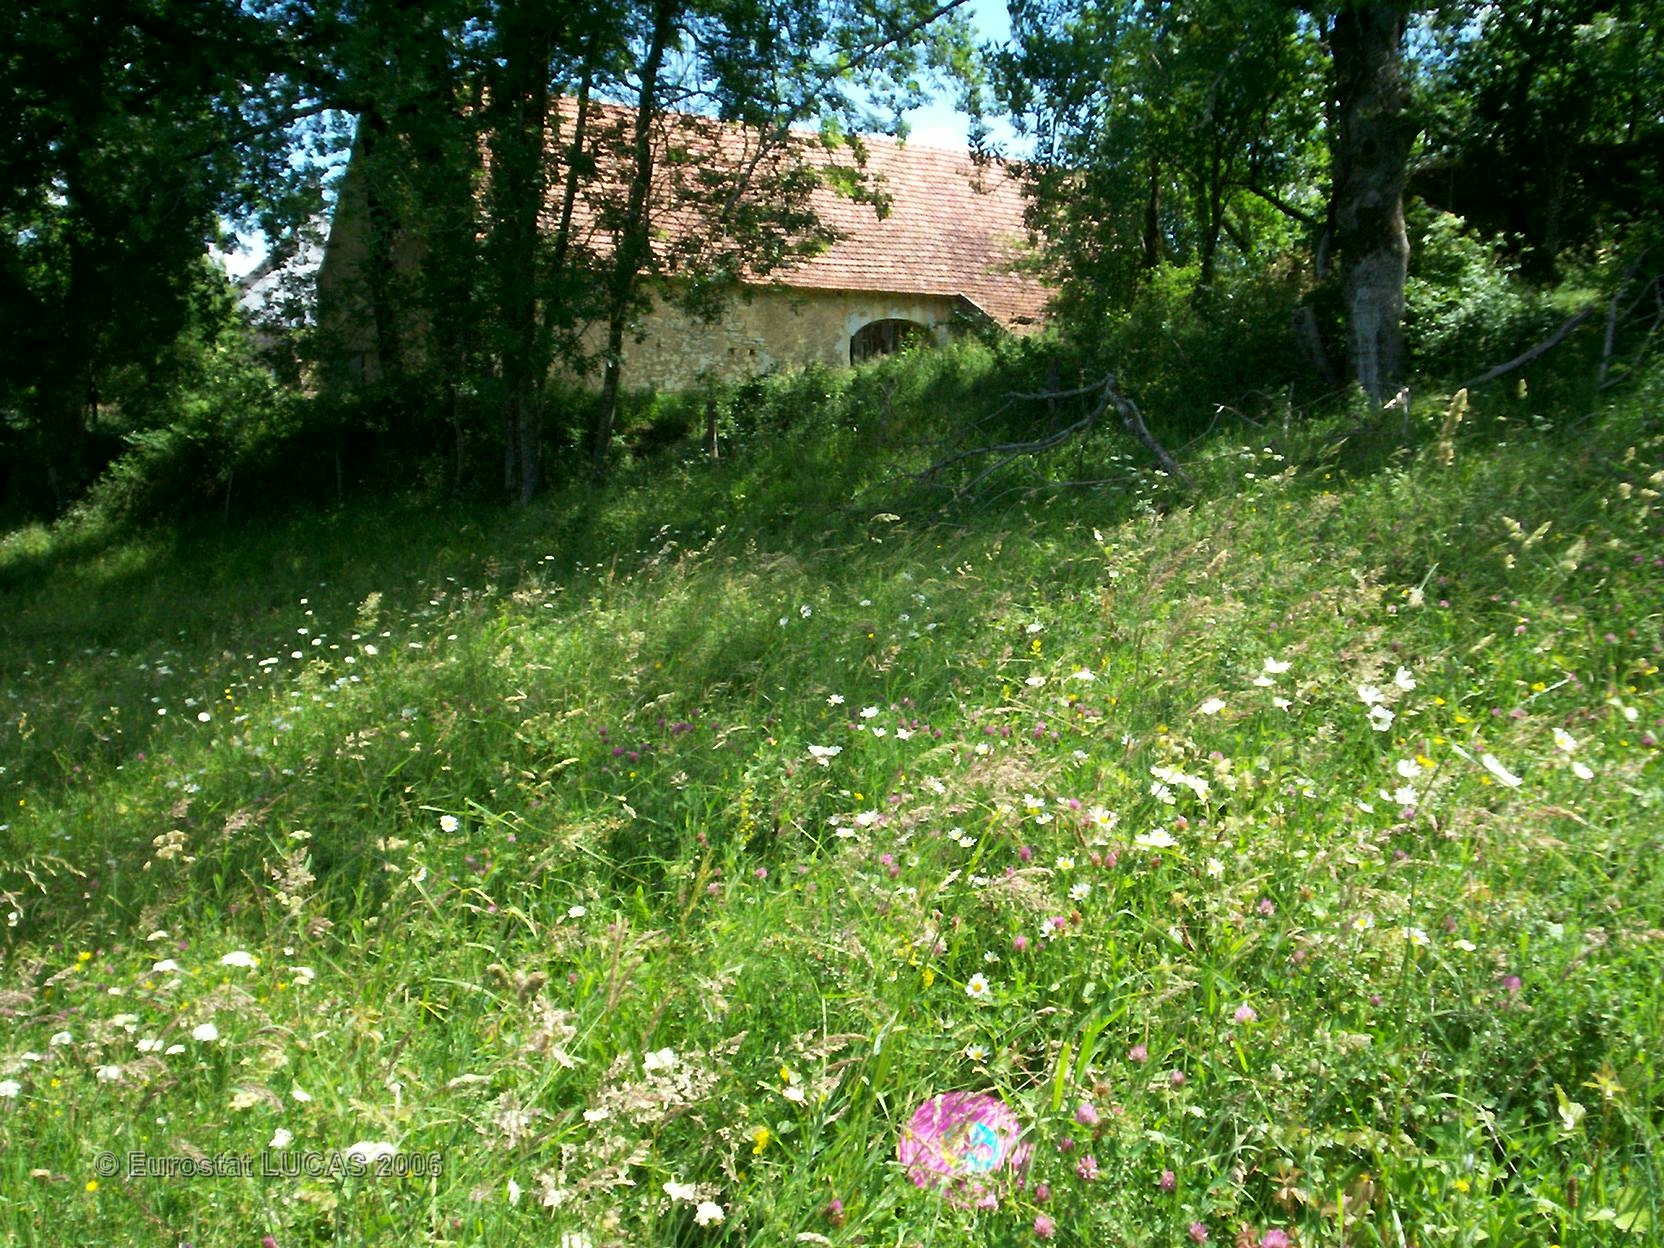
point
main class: Grassland
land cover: Grassland without tree/shrub cover
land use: Agriculture (excluding fallow land and kitchen gardens)
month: May
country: FR
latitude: 44.6265
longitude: 1.3883
